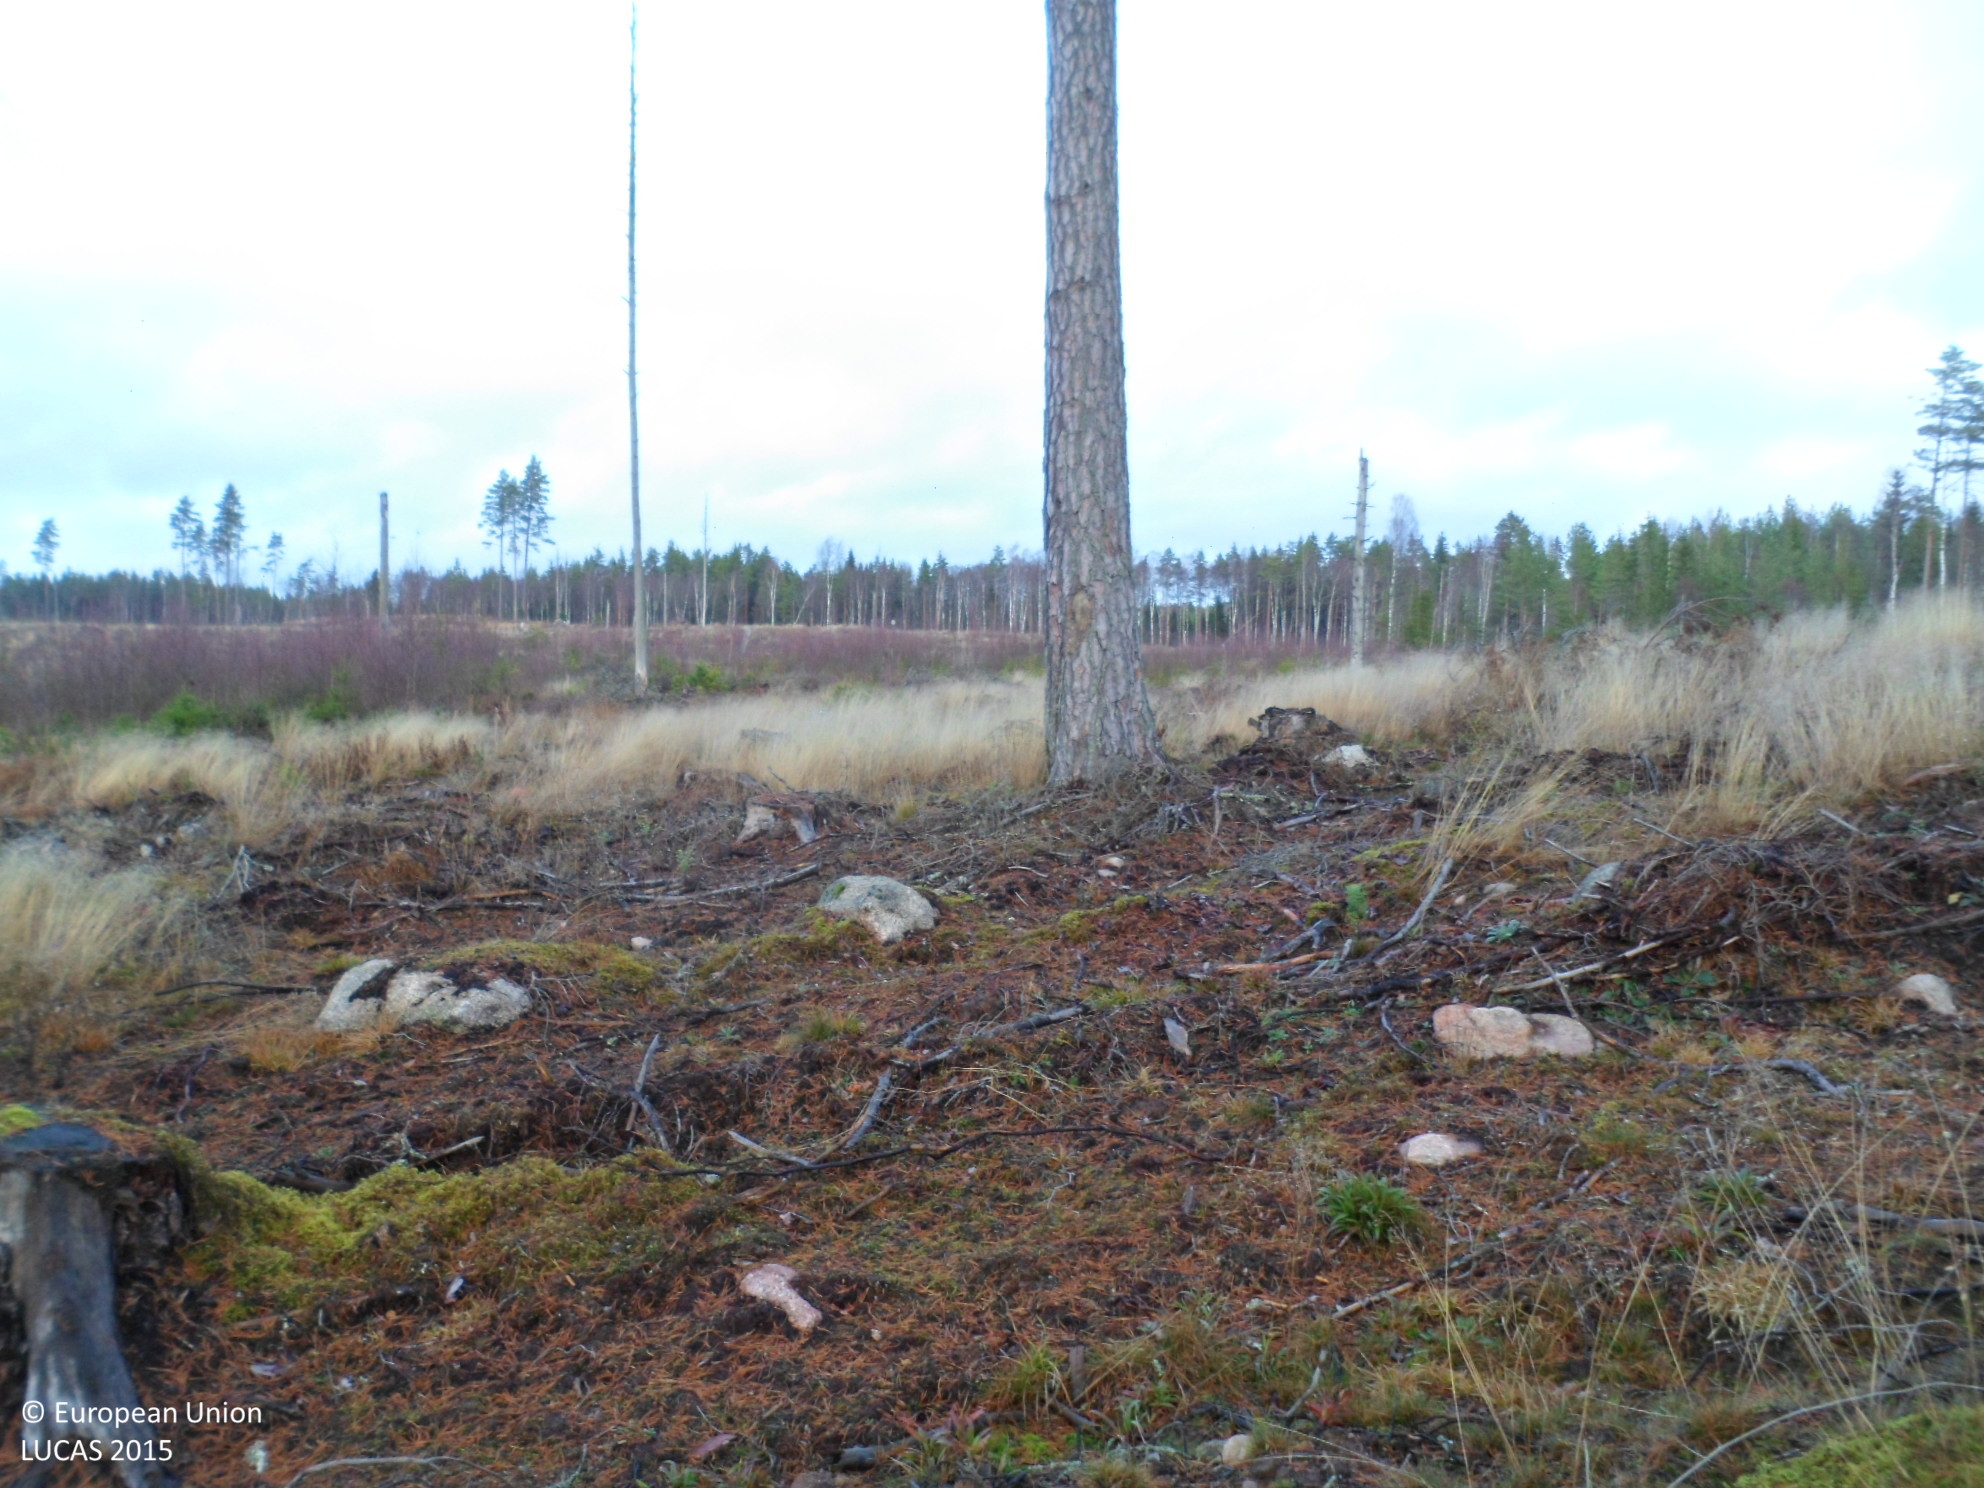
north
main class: Woodland
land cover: Pine dominated coniferous woodland
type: boreal forest
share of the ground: 25 - 50 %
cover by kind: coniferous forest trees 30 %, lichens and mosses 30 %, herbaceous plants 25 %, unconsolidated bare surface 10 %, shrubs 5 %
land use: Forestry
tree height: > 5 m
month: November
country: SE
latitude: 57.6213
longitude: 15.4713
